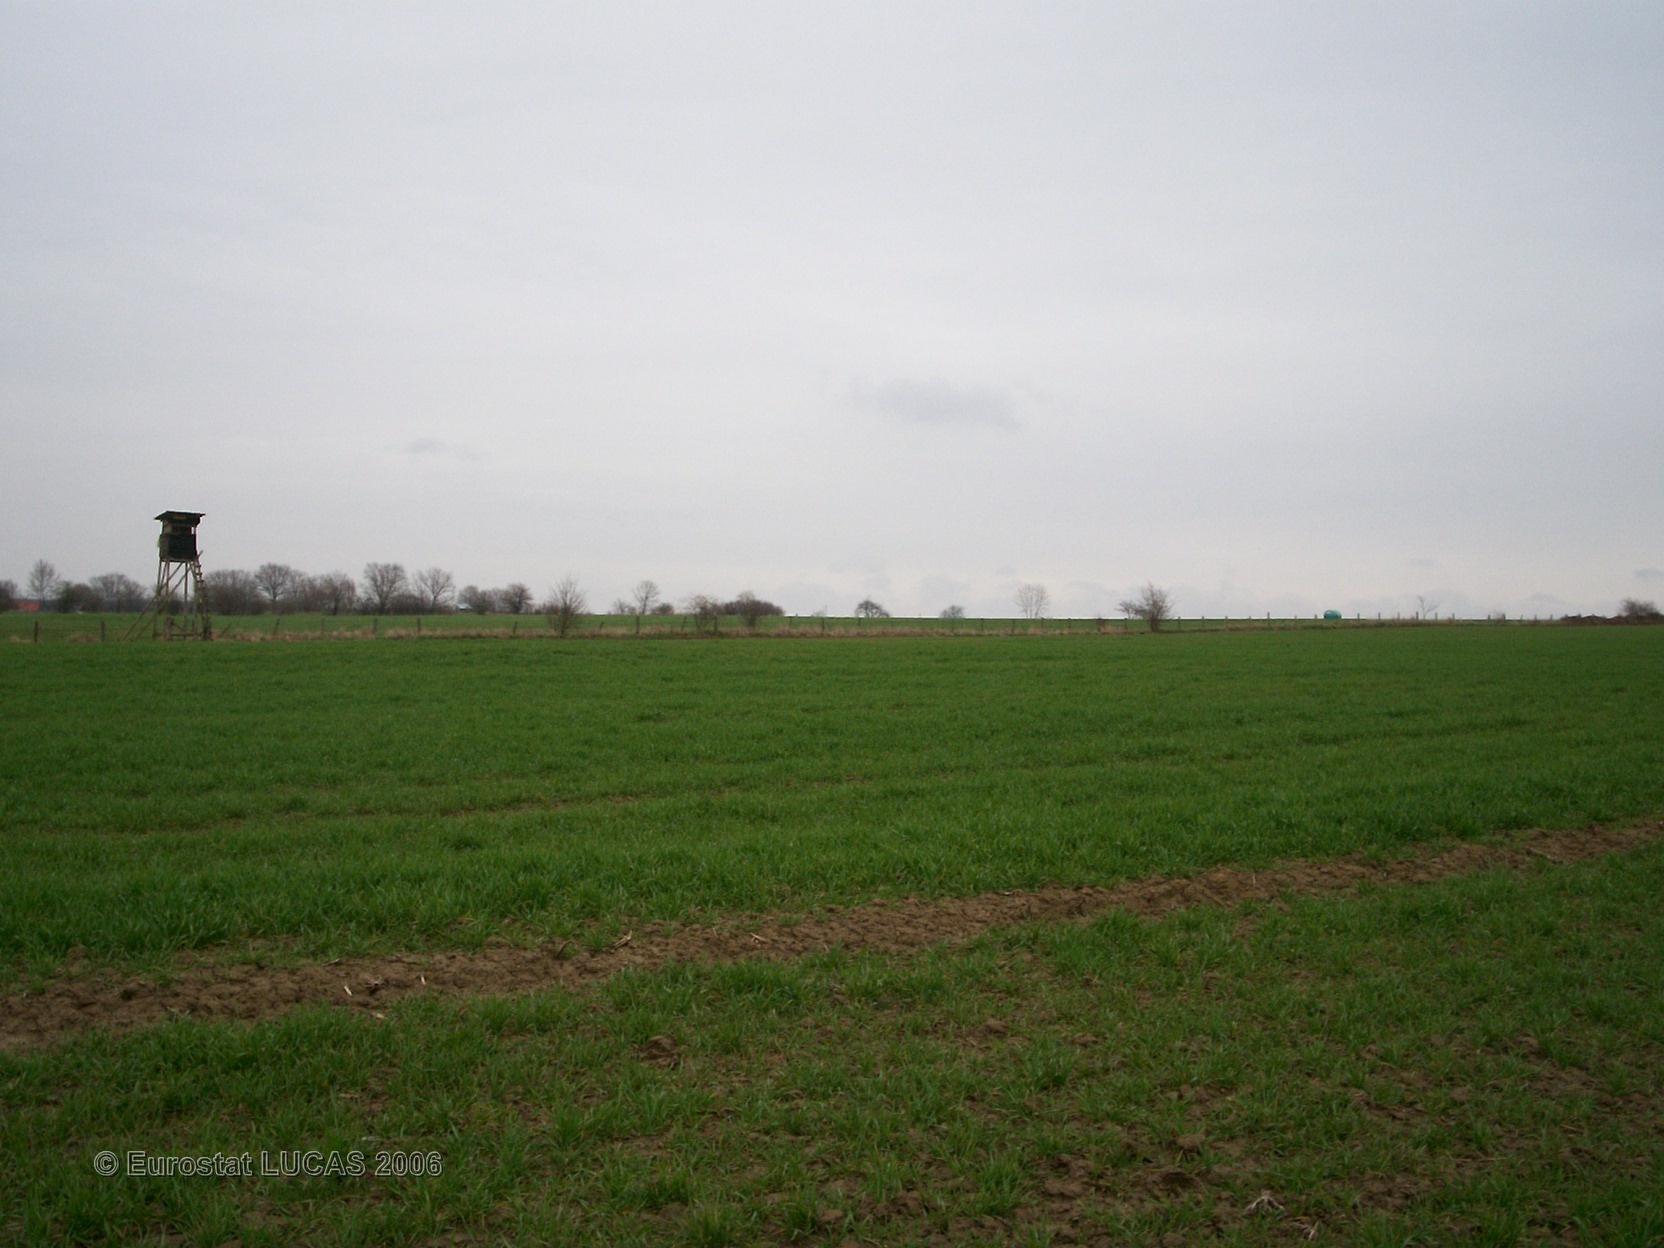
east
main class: Cropland
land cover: Common wheat
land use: Agriculture (excluding fallow land and kitchen gardens)
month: April
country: FR
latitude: 48.6329
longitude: 7.0018
